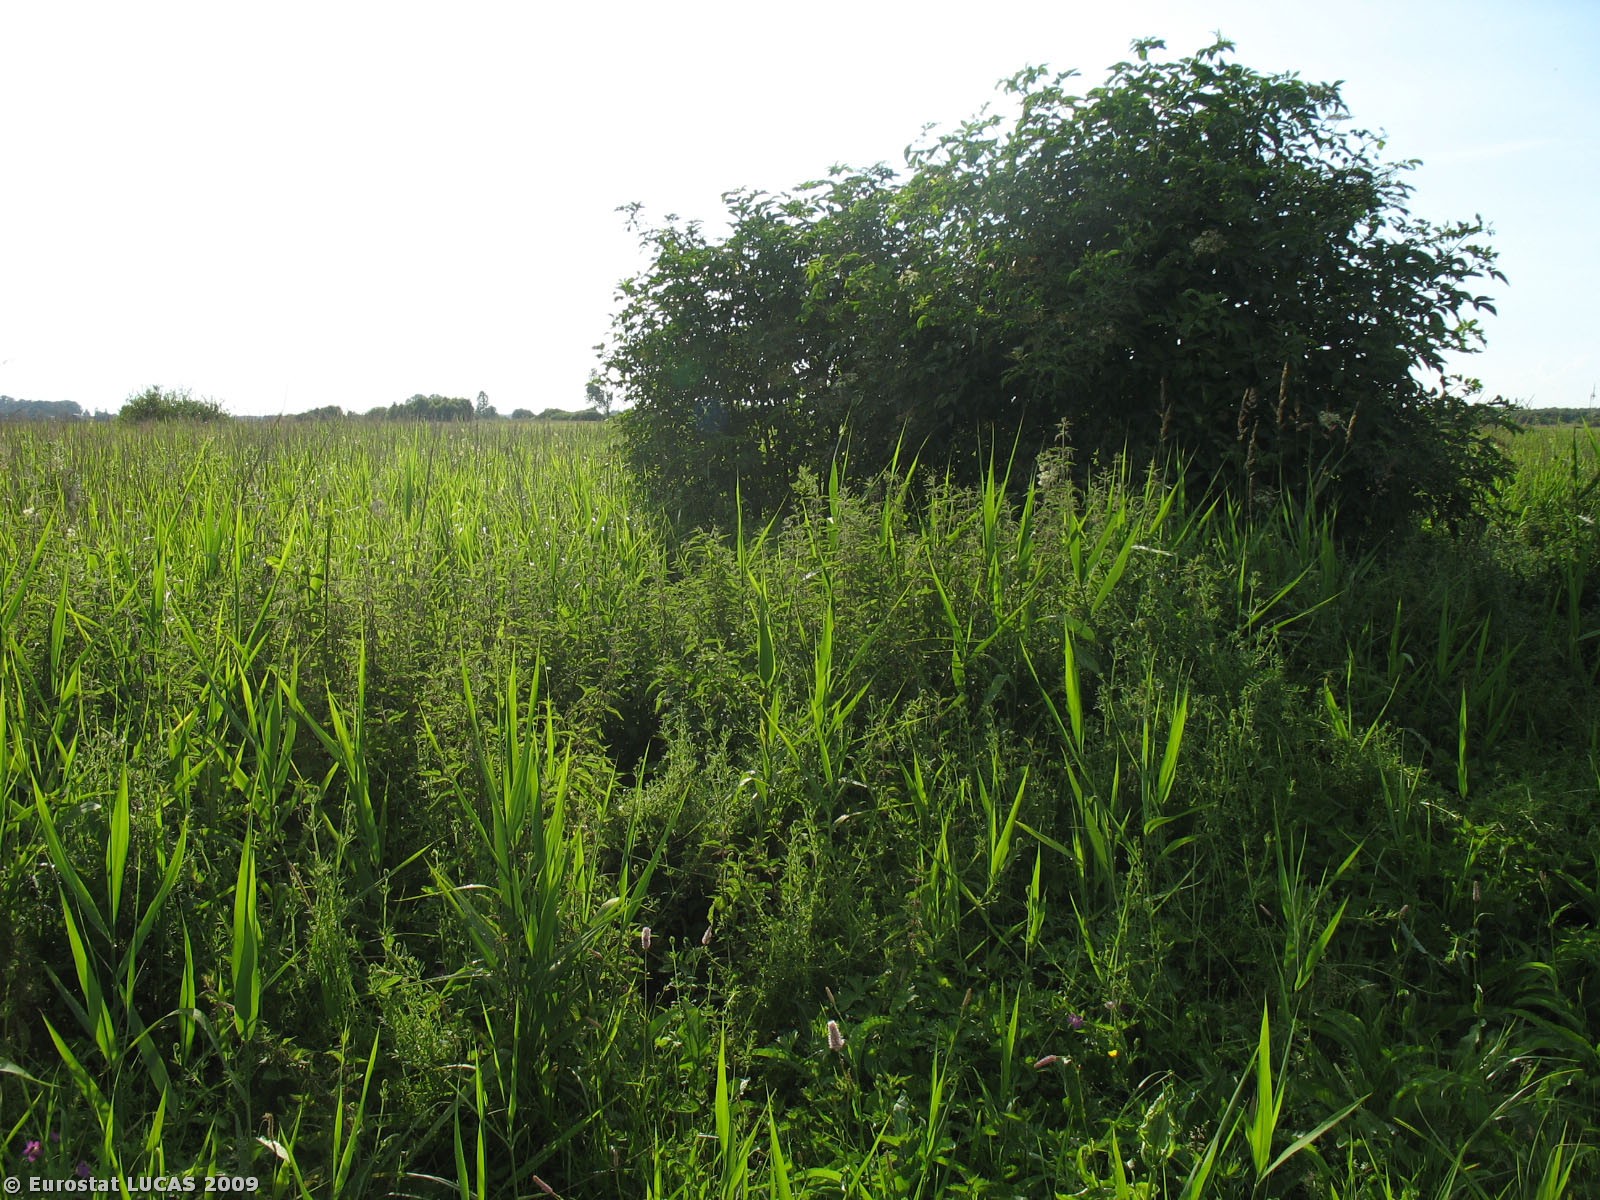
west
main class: Grassland
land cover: Grassland without tree/shrub cover
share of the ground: > 75 %
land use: Agriculture (excluding fallow land and kitchen gardens)
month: July
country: PL
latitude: 50.7706
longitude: 19.8578
